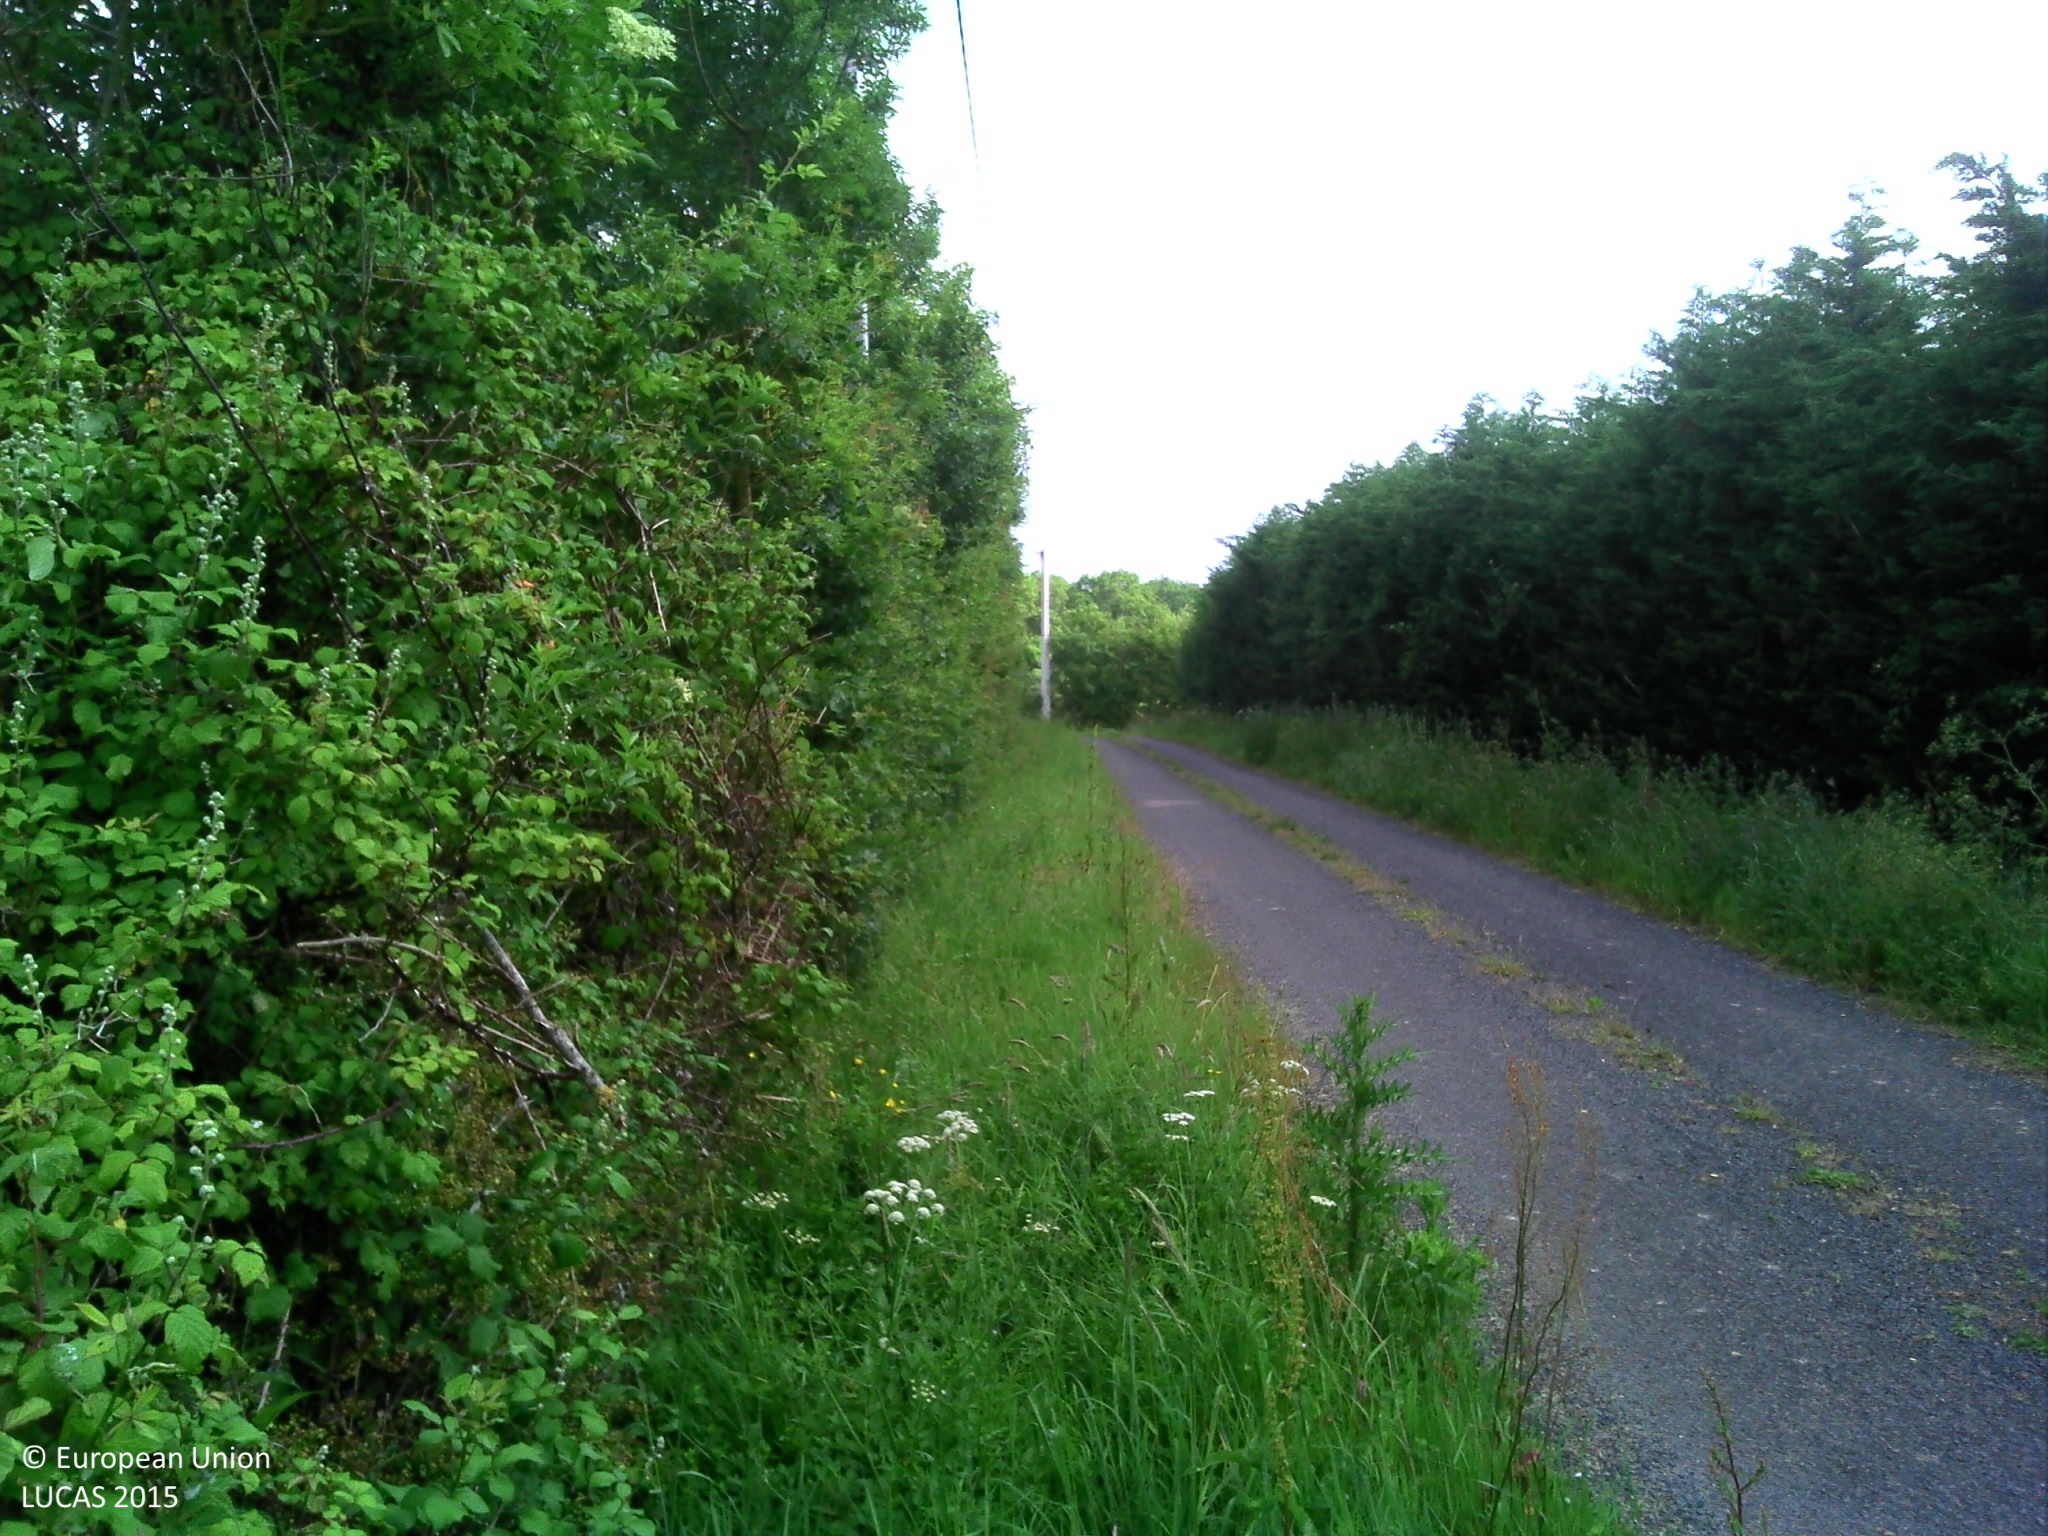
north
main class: Grassland
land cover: Grassland with sparse tree/shrub cover
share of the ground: > 75 %
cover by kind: herbaceous plants 90 %, broadleaved forest trees 5 %, shrubs 5 %
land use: Residential
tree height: < 5 m
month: June
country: FR
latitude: 46.9269
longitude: -1.8514
